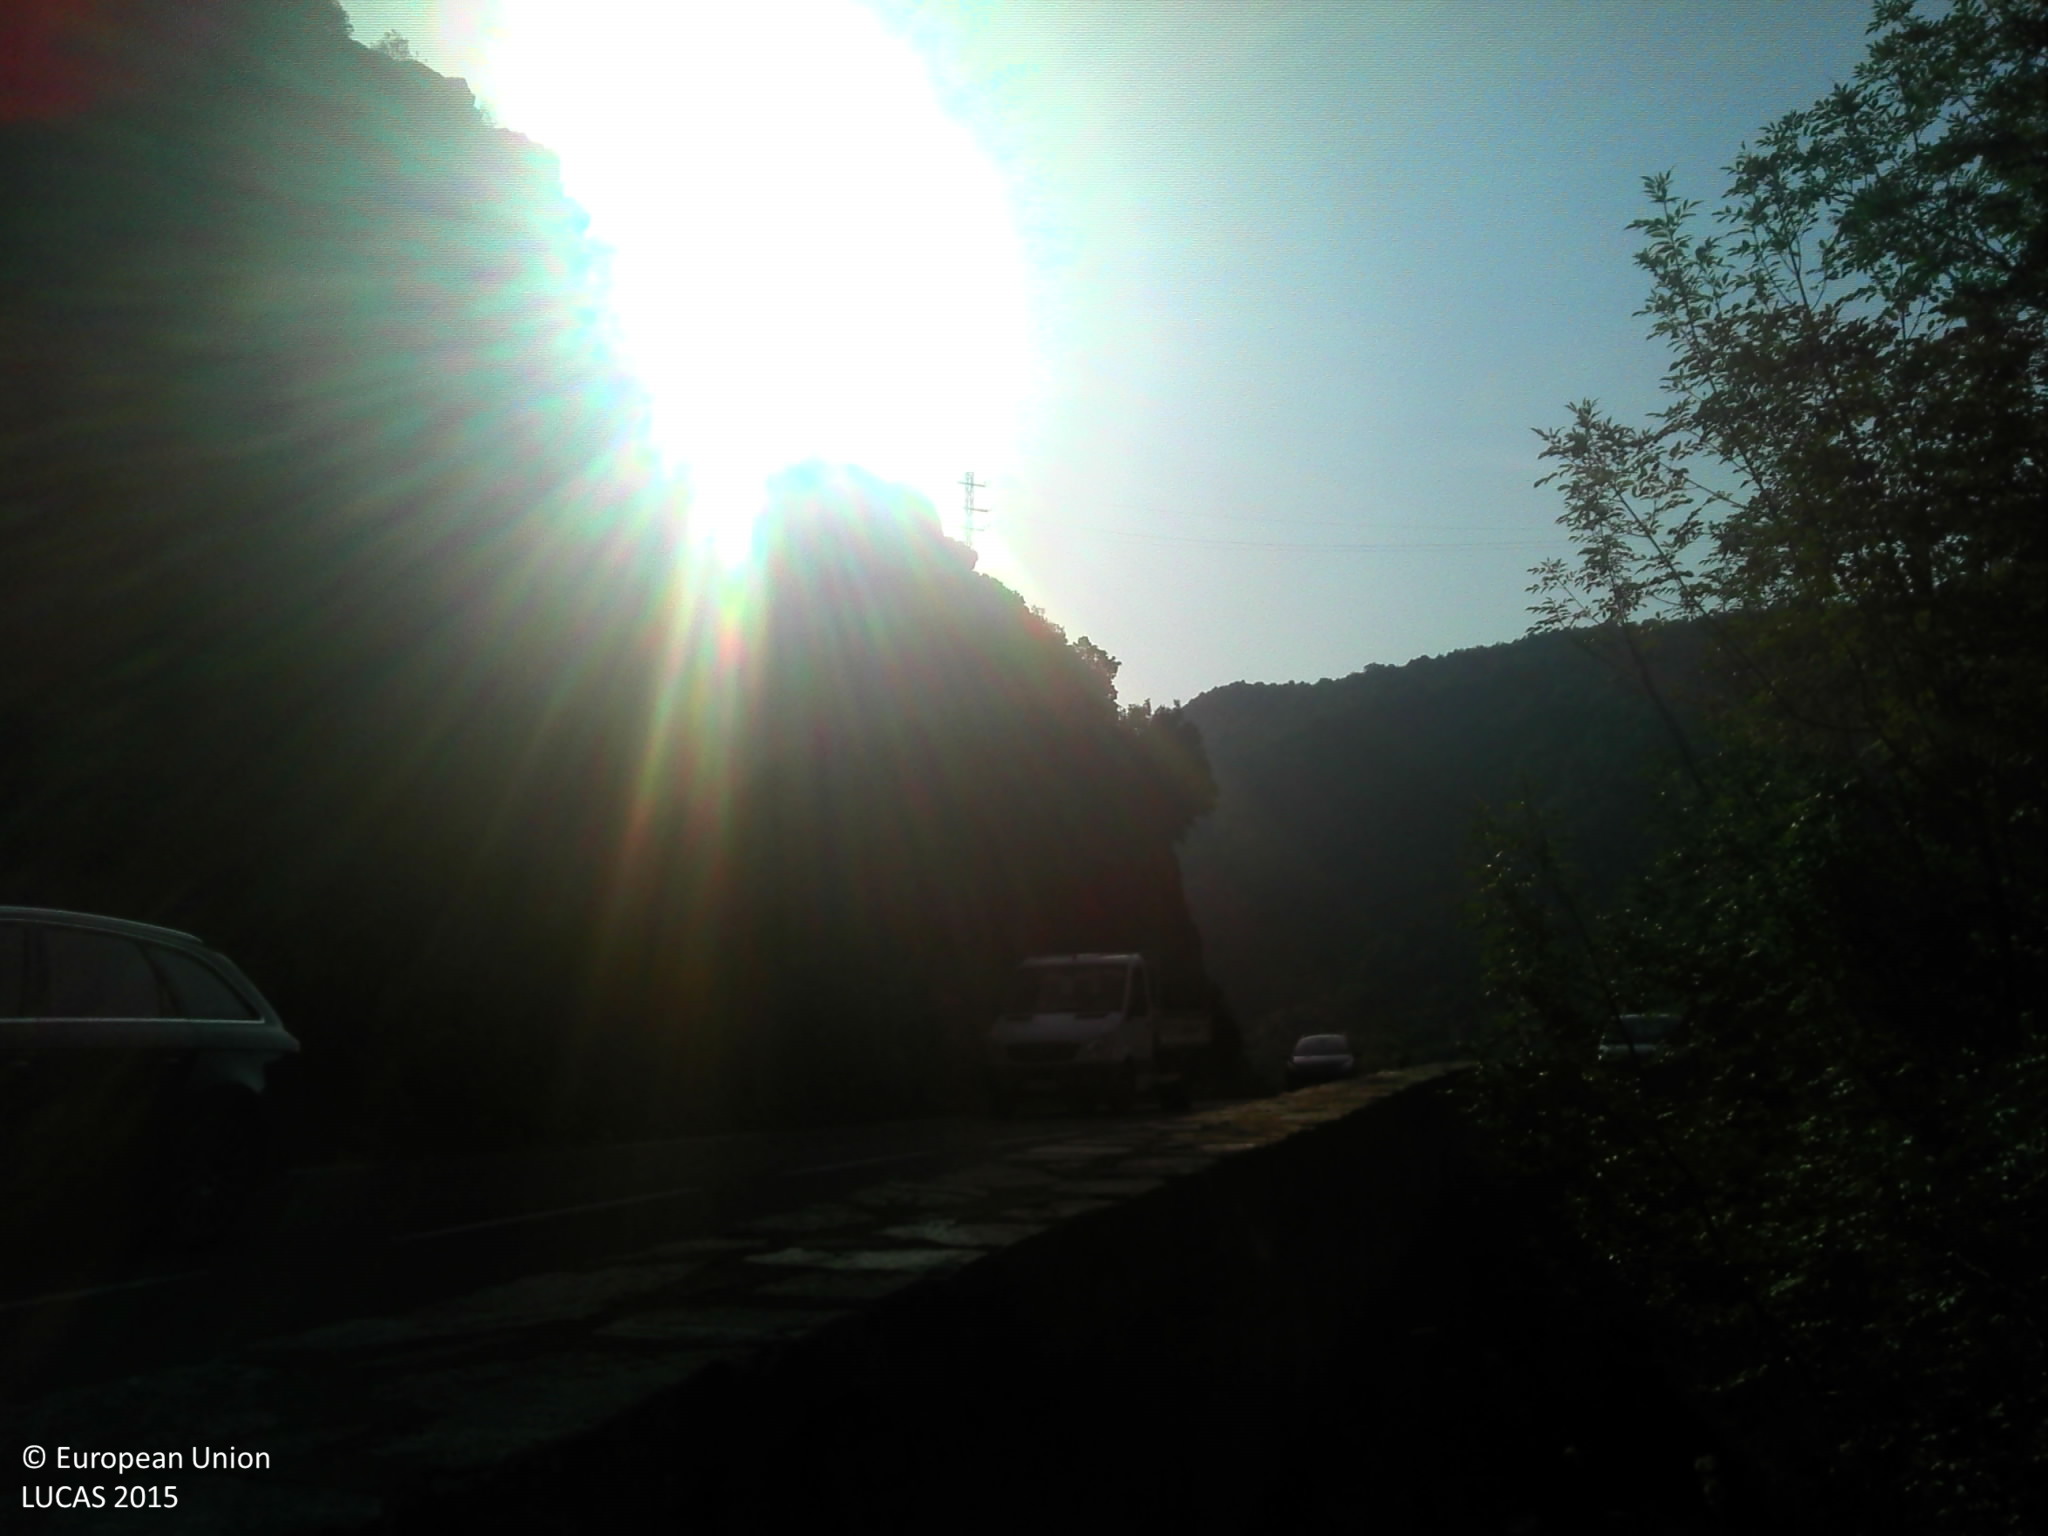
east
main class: Shrubland
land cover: Shrubland without tree cover
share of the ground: > 75 %
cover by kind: shrubs 80 %, consolidated bare surface 20 %
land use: Semi-natural and natural areas not in use
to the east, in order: Shrubland without tree cover; Rocks and stones; Shrubland with sparse tree cover; Rocks and stones; Shrubland with sparse tree cover; Electric lines; Shrubland without tree cover; Dry stone walls; Shrubland with sparse tree cover
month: July
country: FR
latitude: 42.5073
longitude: 9.3330
